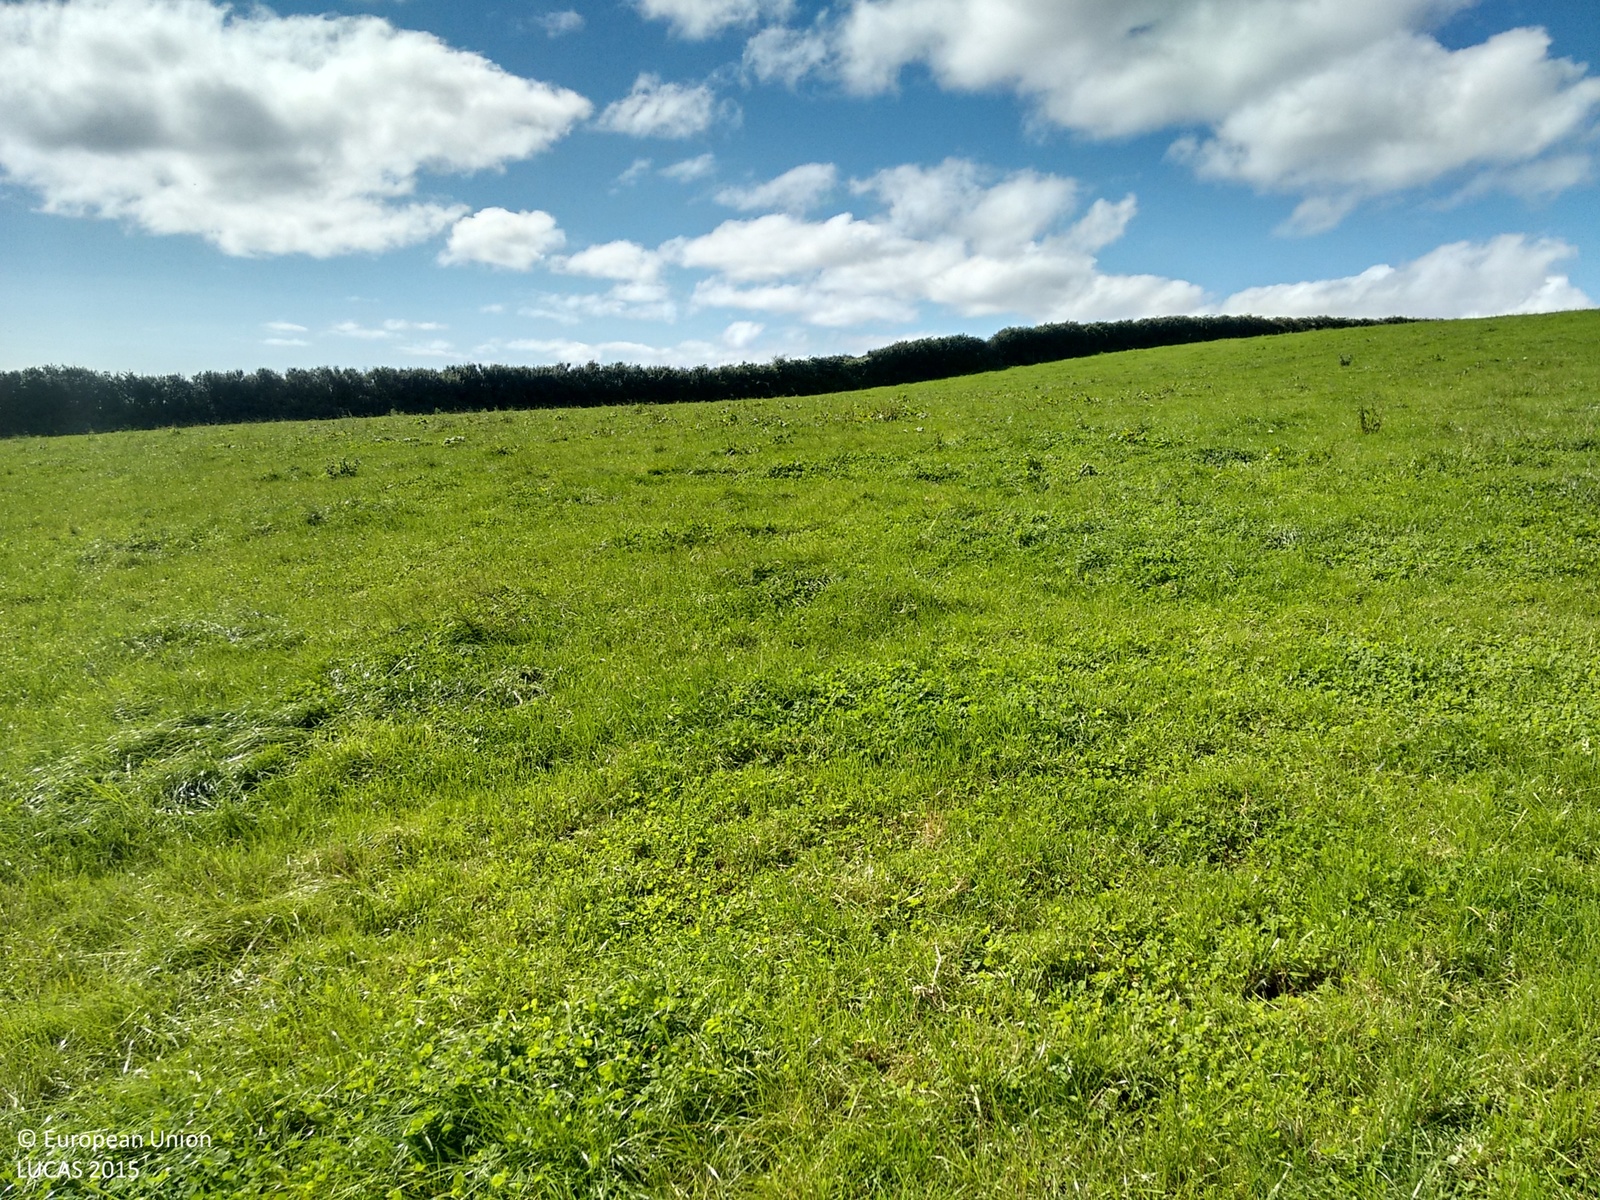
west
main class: Grassland
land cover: Grassland without tree/shrub cover
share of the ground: > 75 %
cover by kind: herbaceous plants 100 %
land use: Agriculture (excluding fallow land and kitchen gardens)
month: September
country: GB
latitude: 50.0968
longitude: -5.2898
